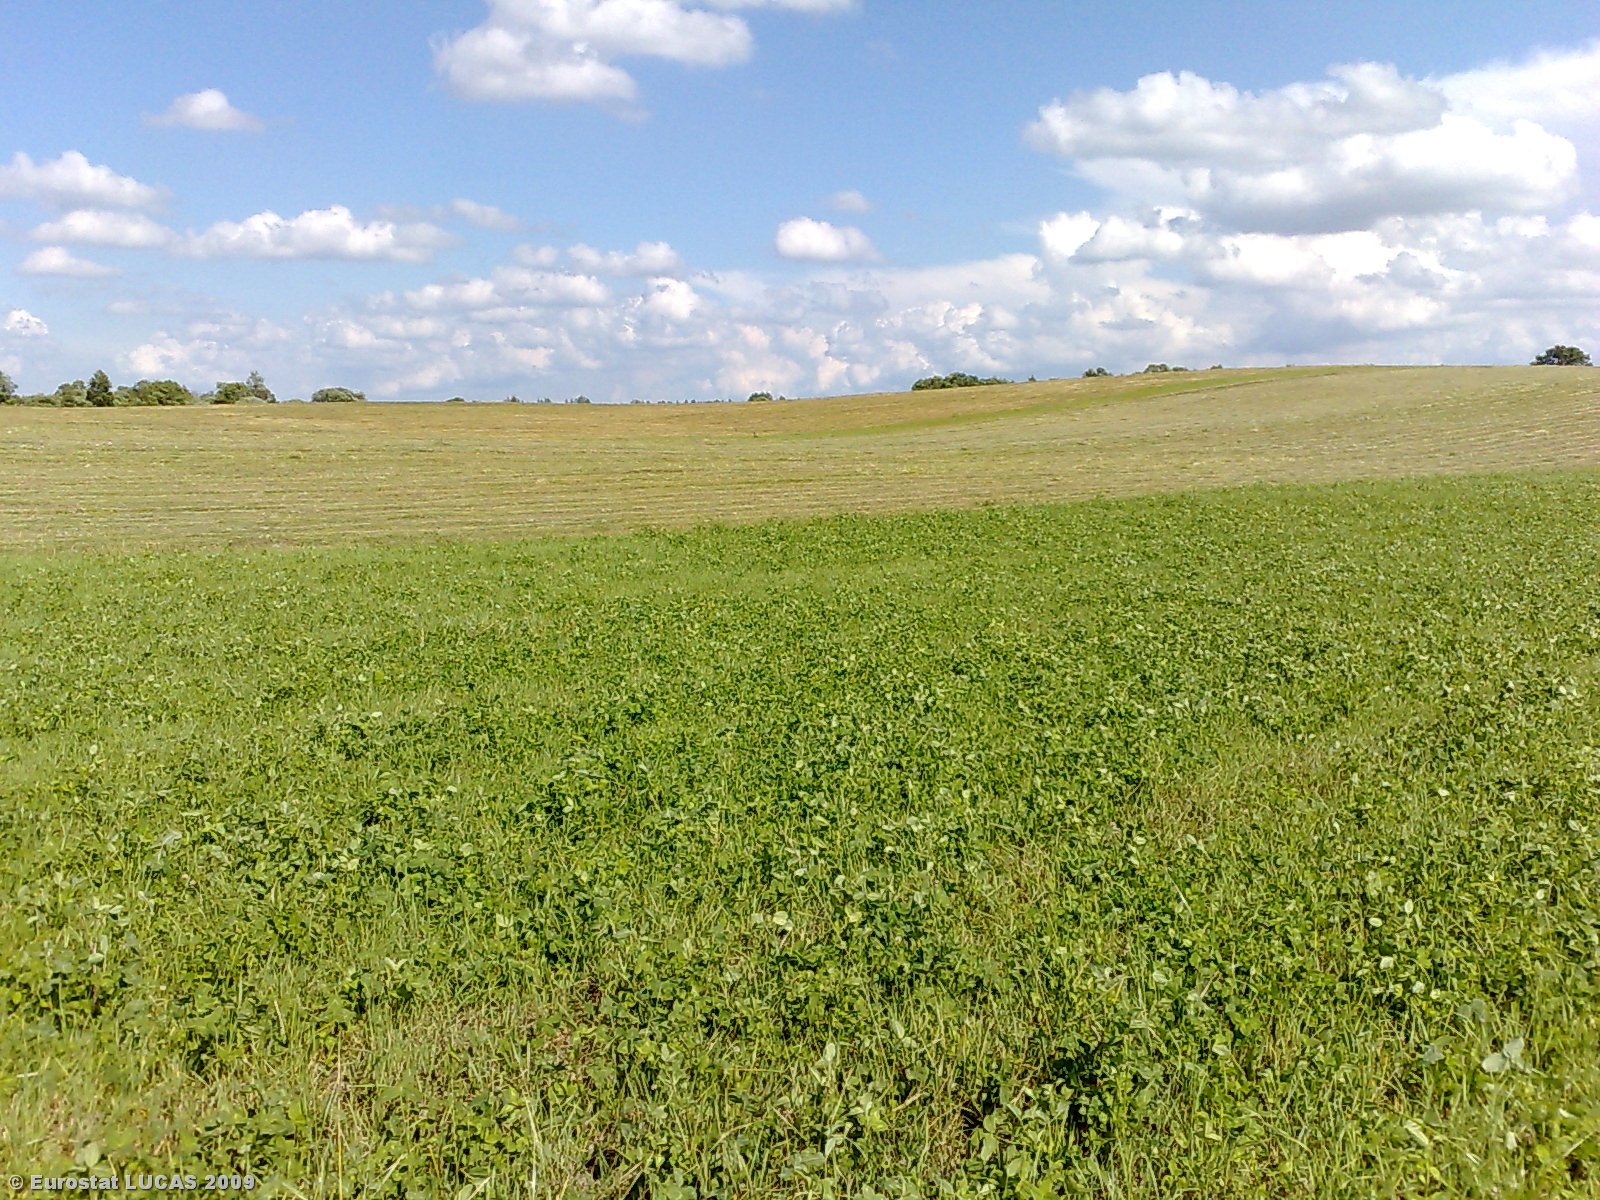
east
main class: Cropland
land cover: Clovers
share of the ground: > 75 %
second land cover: Grassland without tree/shrub cover
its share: 50 - 75 %
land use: Agriculture (excluding fallow land and kitchen gardens)
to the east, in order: Clovers; Grassland without tree/shrub cover
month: July
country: LT
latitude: 55.5265
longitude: 22.7864
